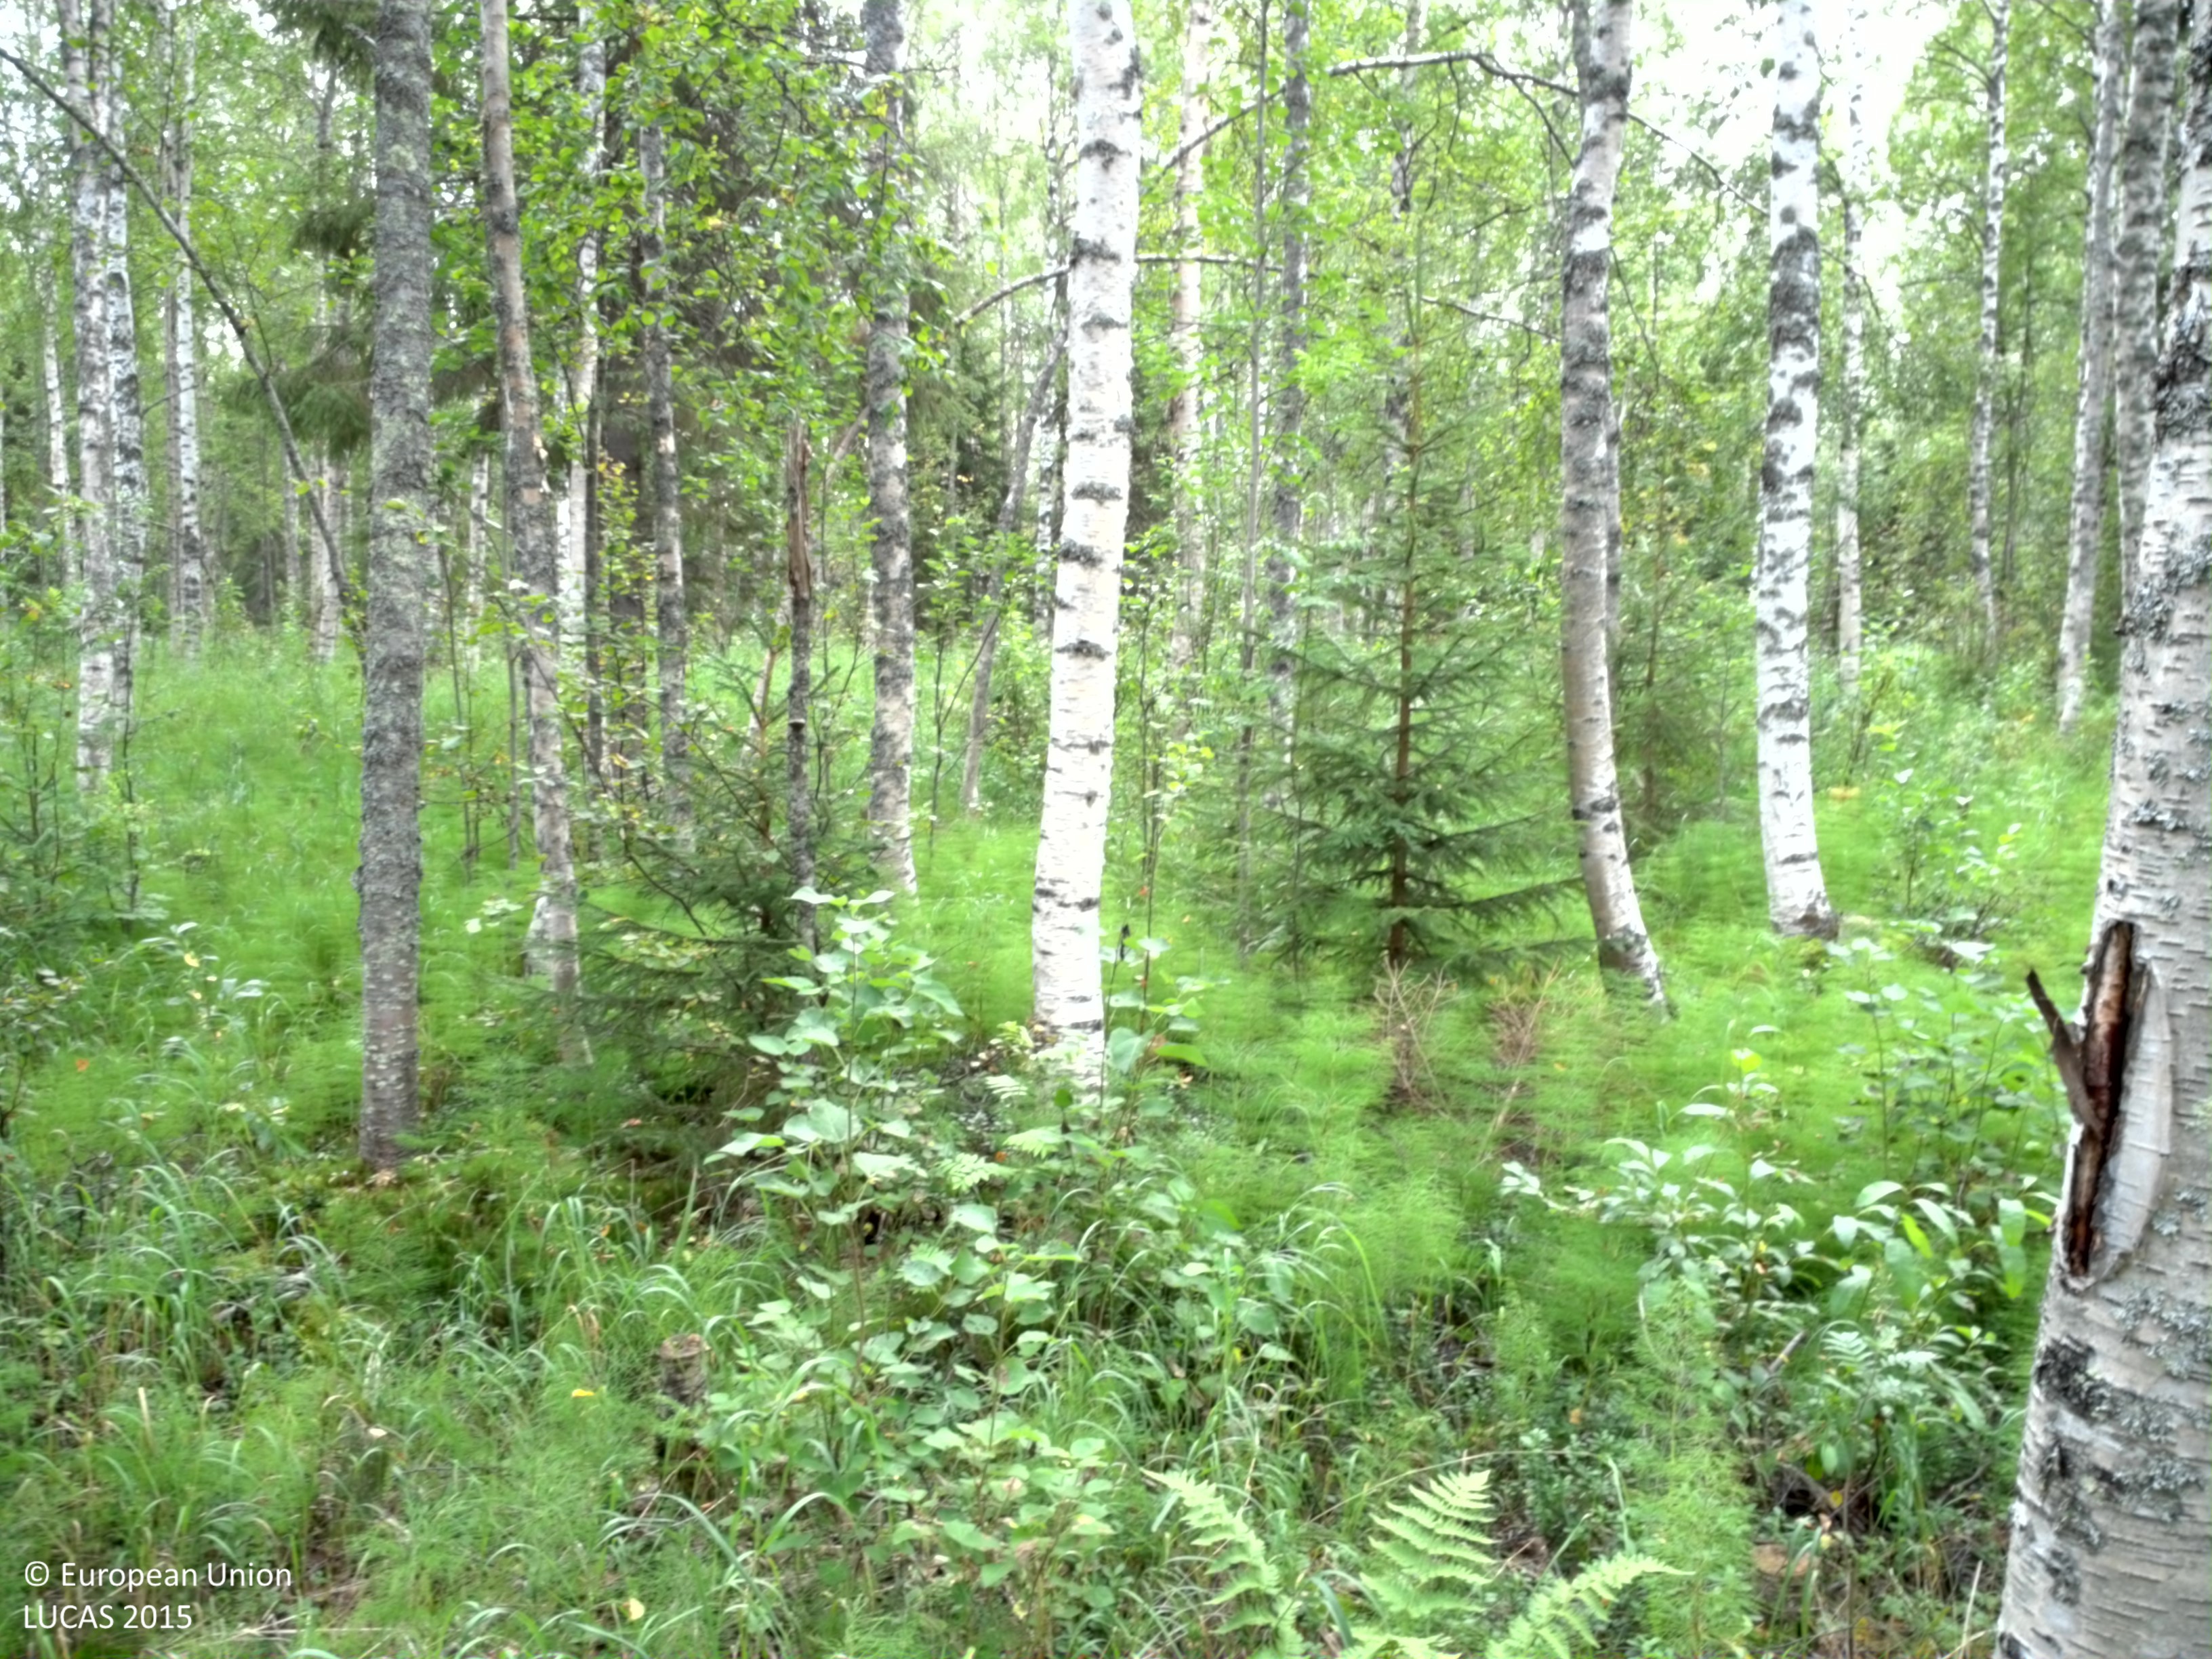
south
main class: Woodland
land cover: Broadleaved woodland
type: non-riverine alder, birch or aspen forest
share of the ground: 25 - 50 %
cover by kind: shrubs 50 %, broadleaved forest trees 40 %, coniferous forest trees 5 %, lichens and mosses 5 %
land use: Forestry
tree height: > 5 m
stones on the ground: < 10 %
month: August
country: SE
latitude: 65.8911
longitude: 22.6405
